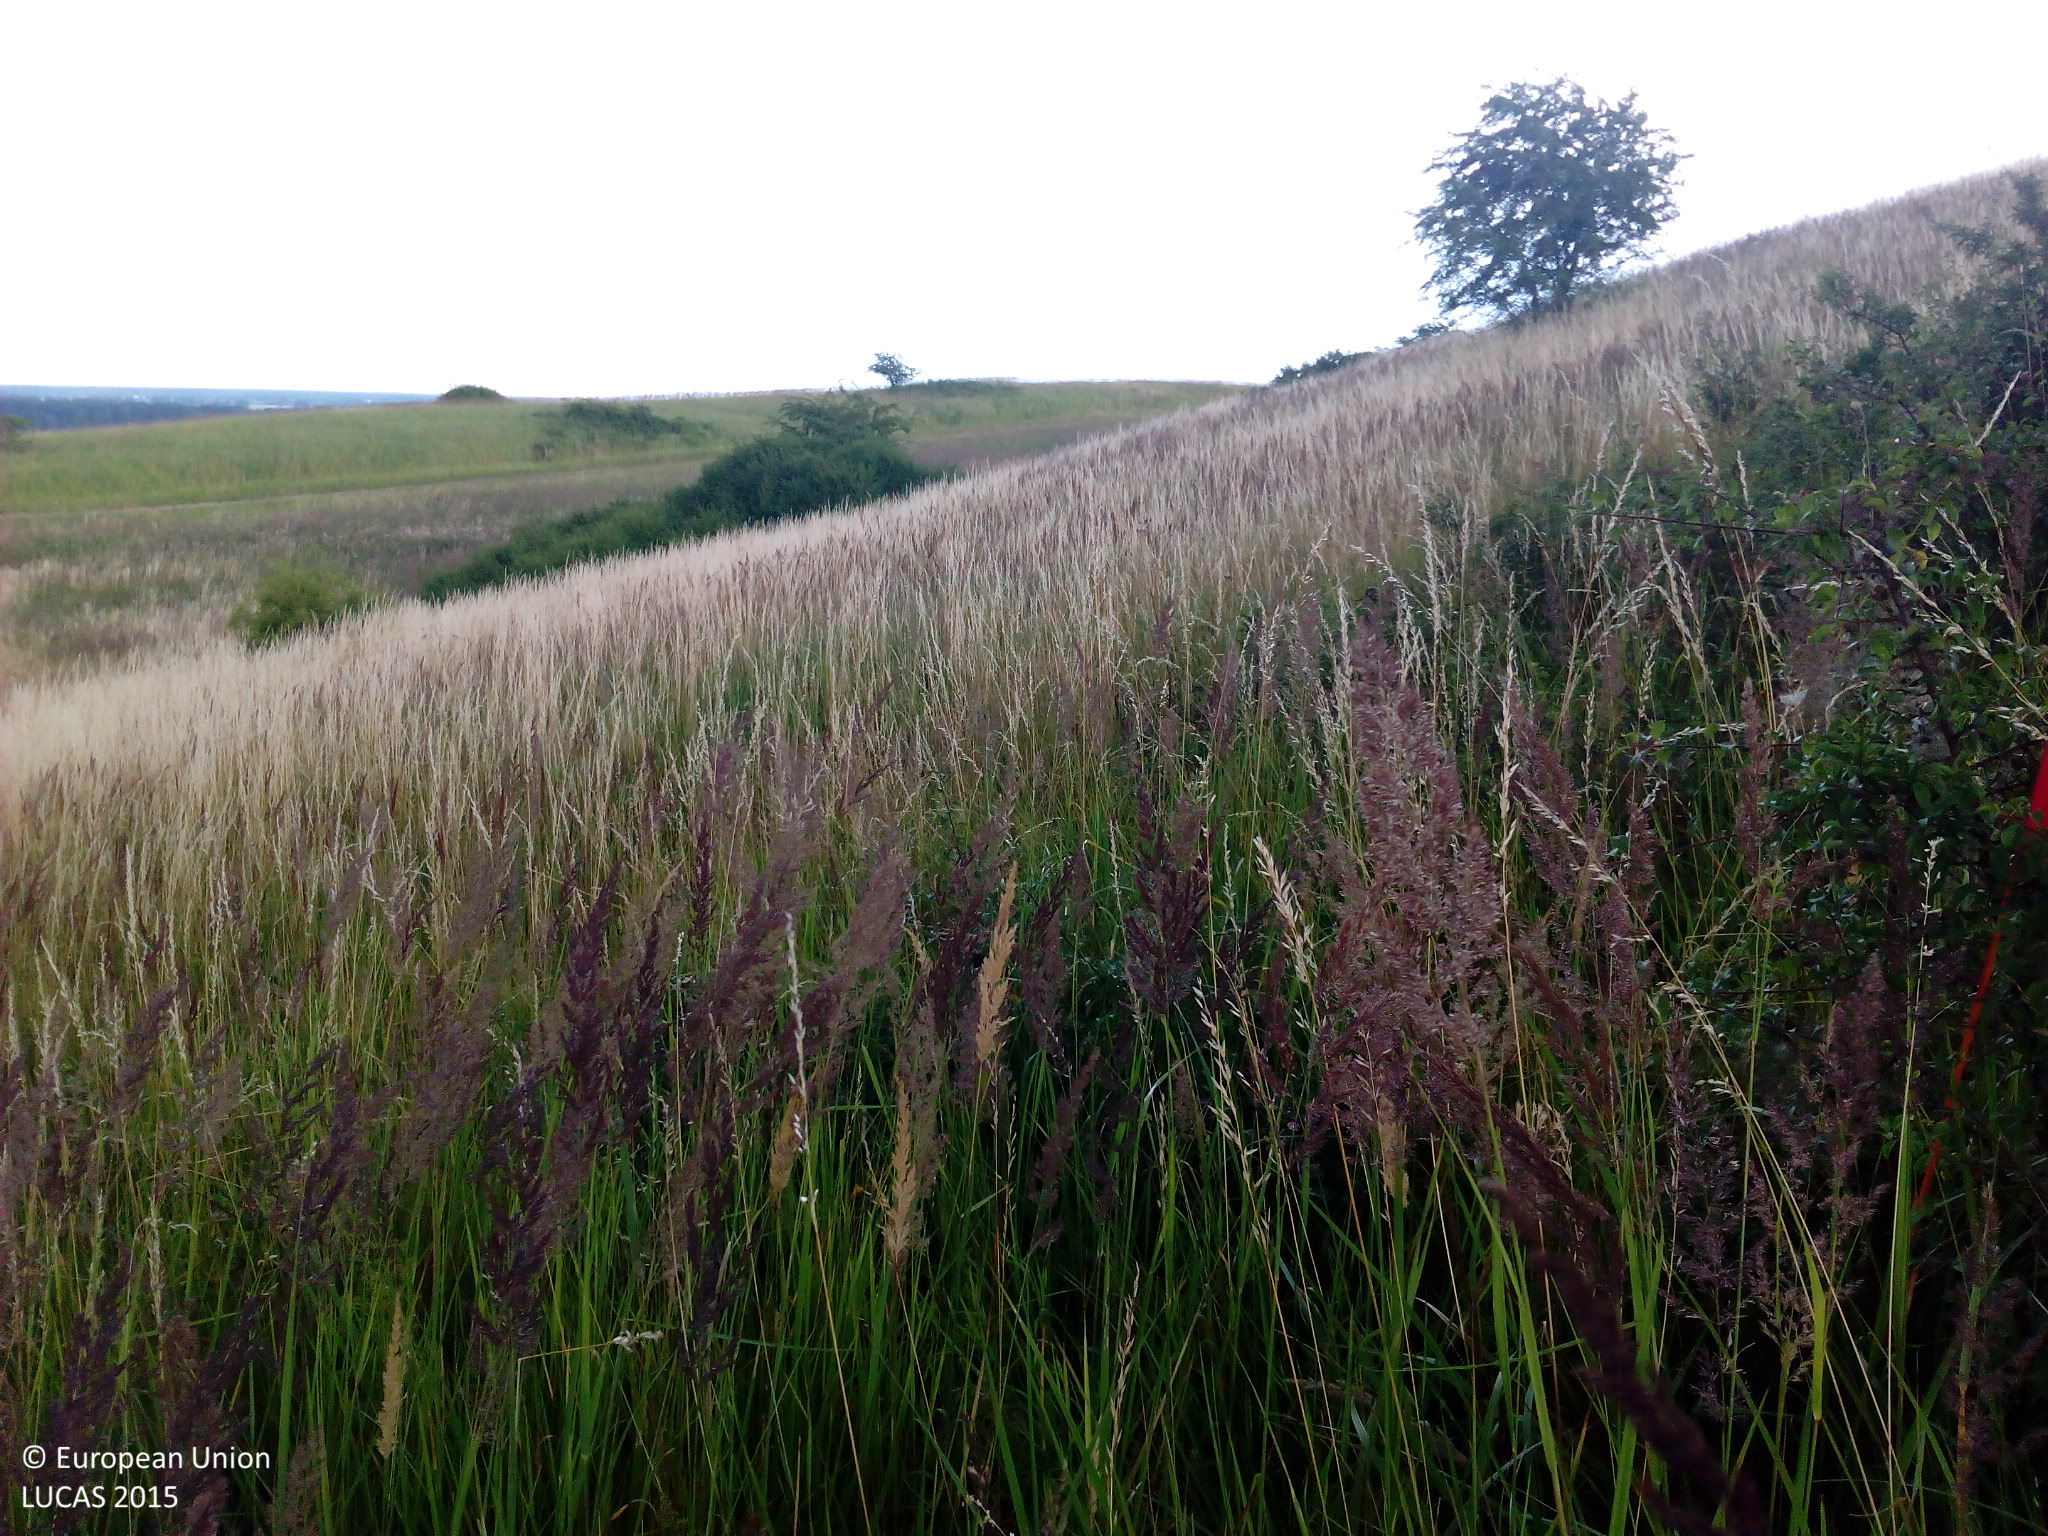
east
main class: Shrubland
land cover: Shrubland without tree cover
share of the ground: 10 - 25 %
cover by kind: herbaceous plants 80 %, shrubs 20 %
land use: Semi-natural and natural areas not in use
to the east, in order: Shrubland without tree cover; Grassland without tree/shrub cover; Shrubland without tree cover; Grassland without tree/shrub cover; Tracks; Grassland without tree/shrub cover; Shrubland without tree cover; Maize
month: July
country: DE
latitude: 53.5973
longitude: 13.7019
